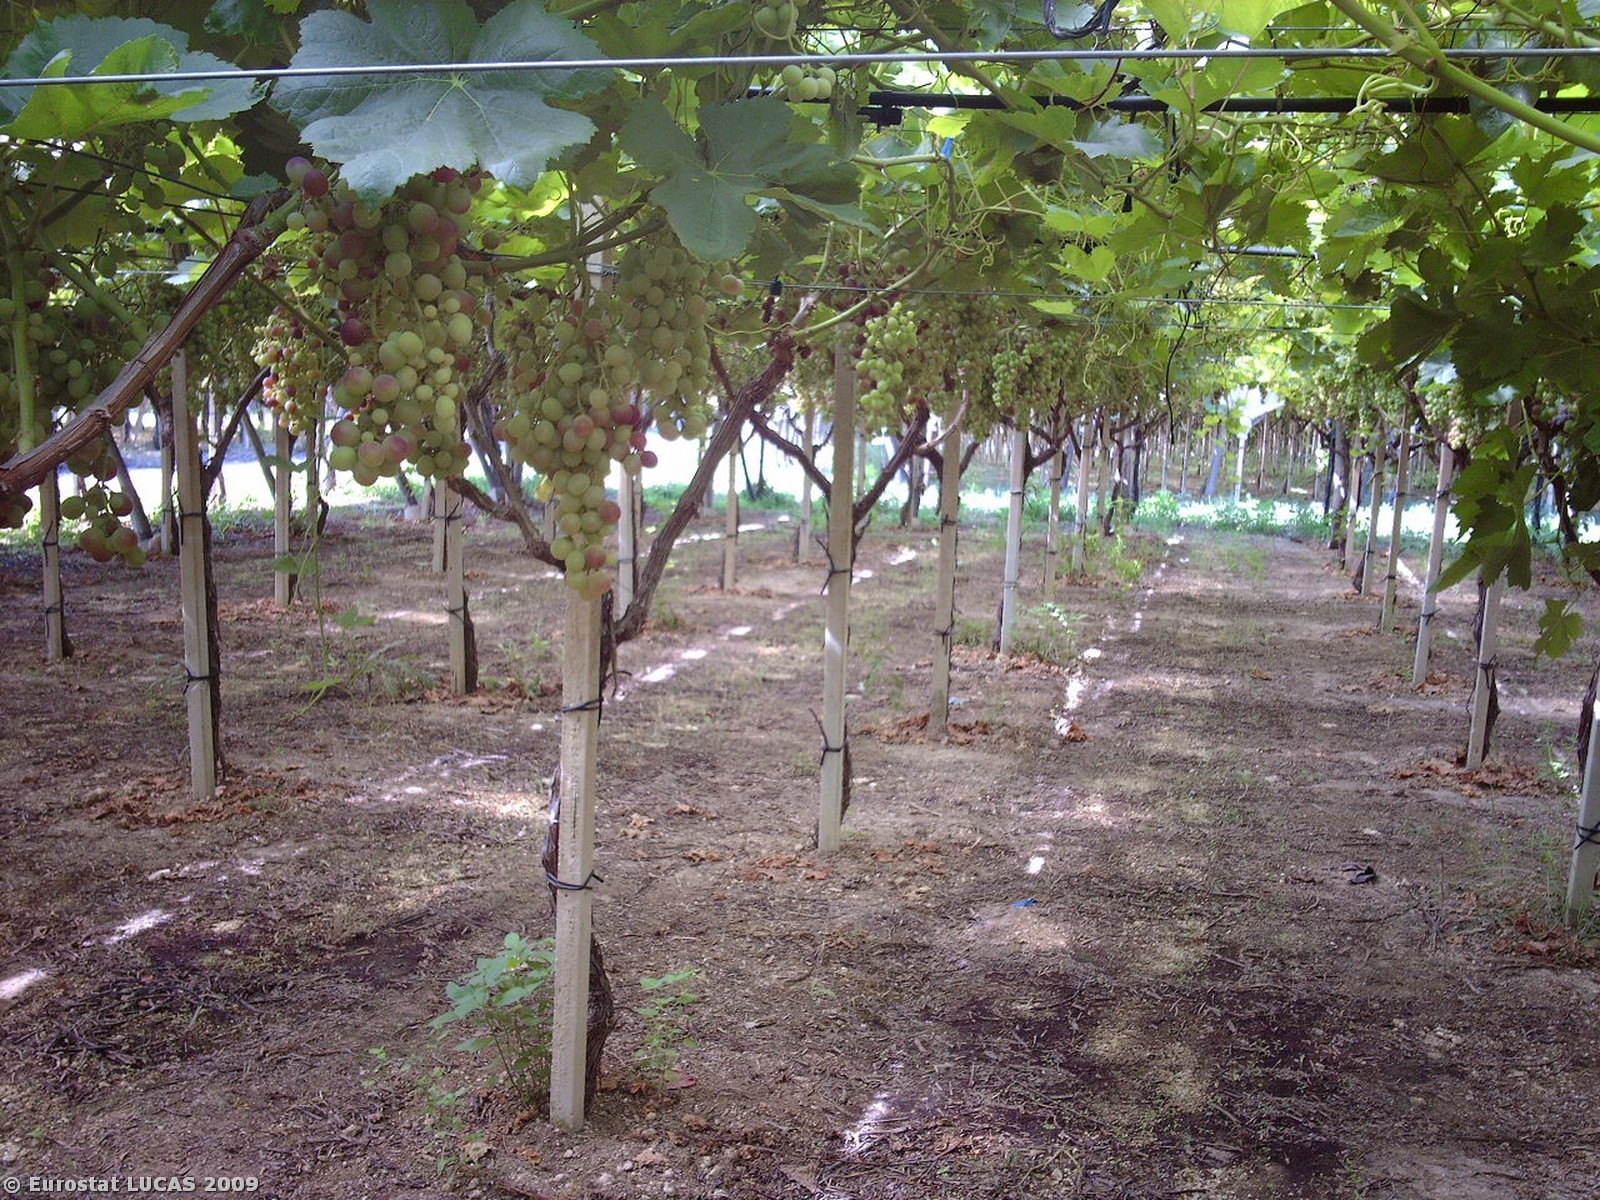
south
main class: Cropland
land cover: Vineyards
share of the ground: 50 - 75 %
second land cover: Bare land
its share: 50 - 75 %
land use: Agriculture (excluding fallow land and kitchen gardens)
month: July
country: IT
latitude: 41.0363
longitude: 16.9613
